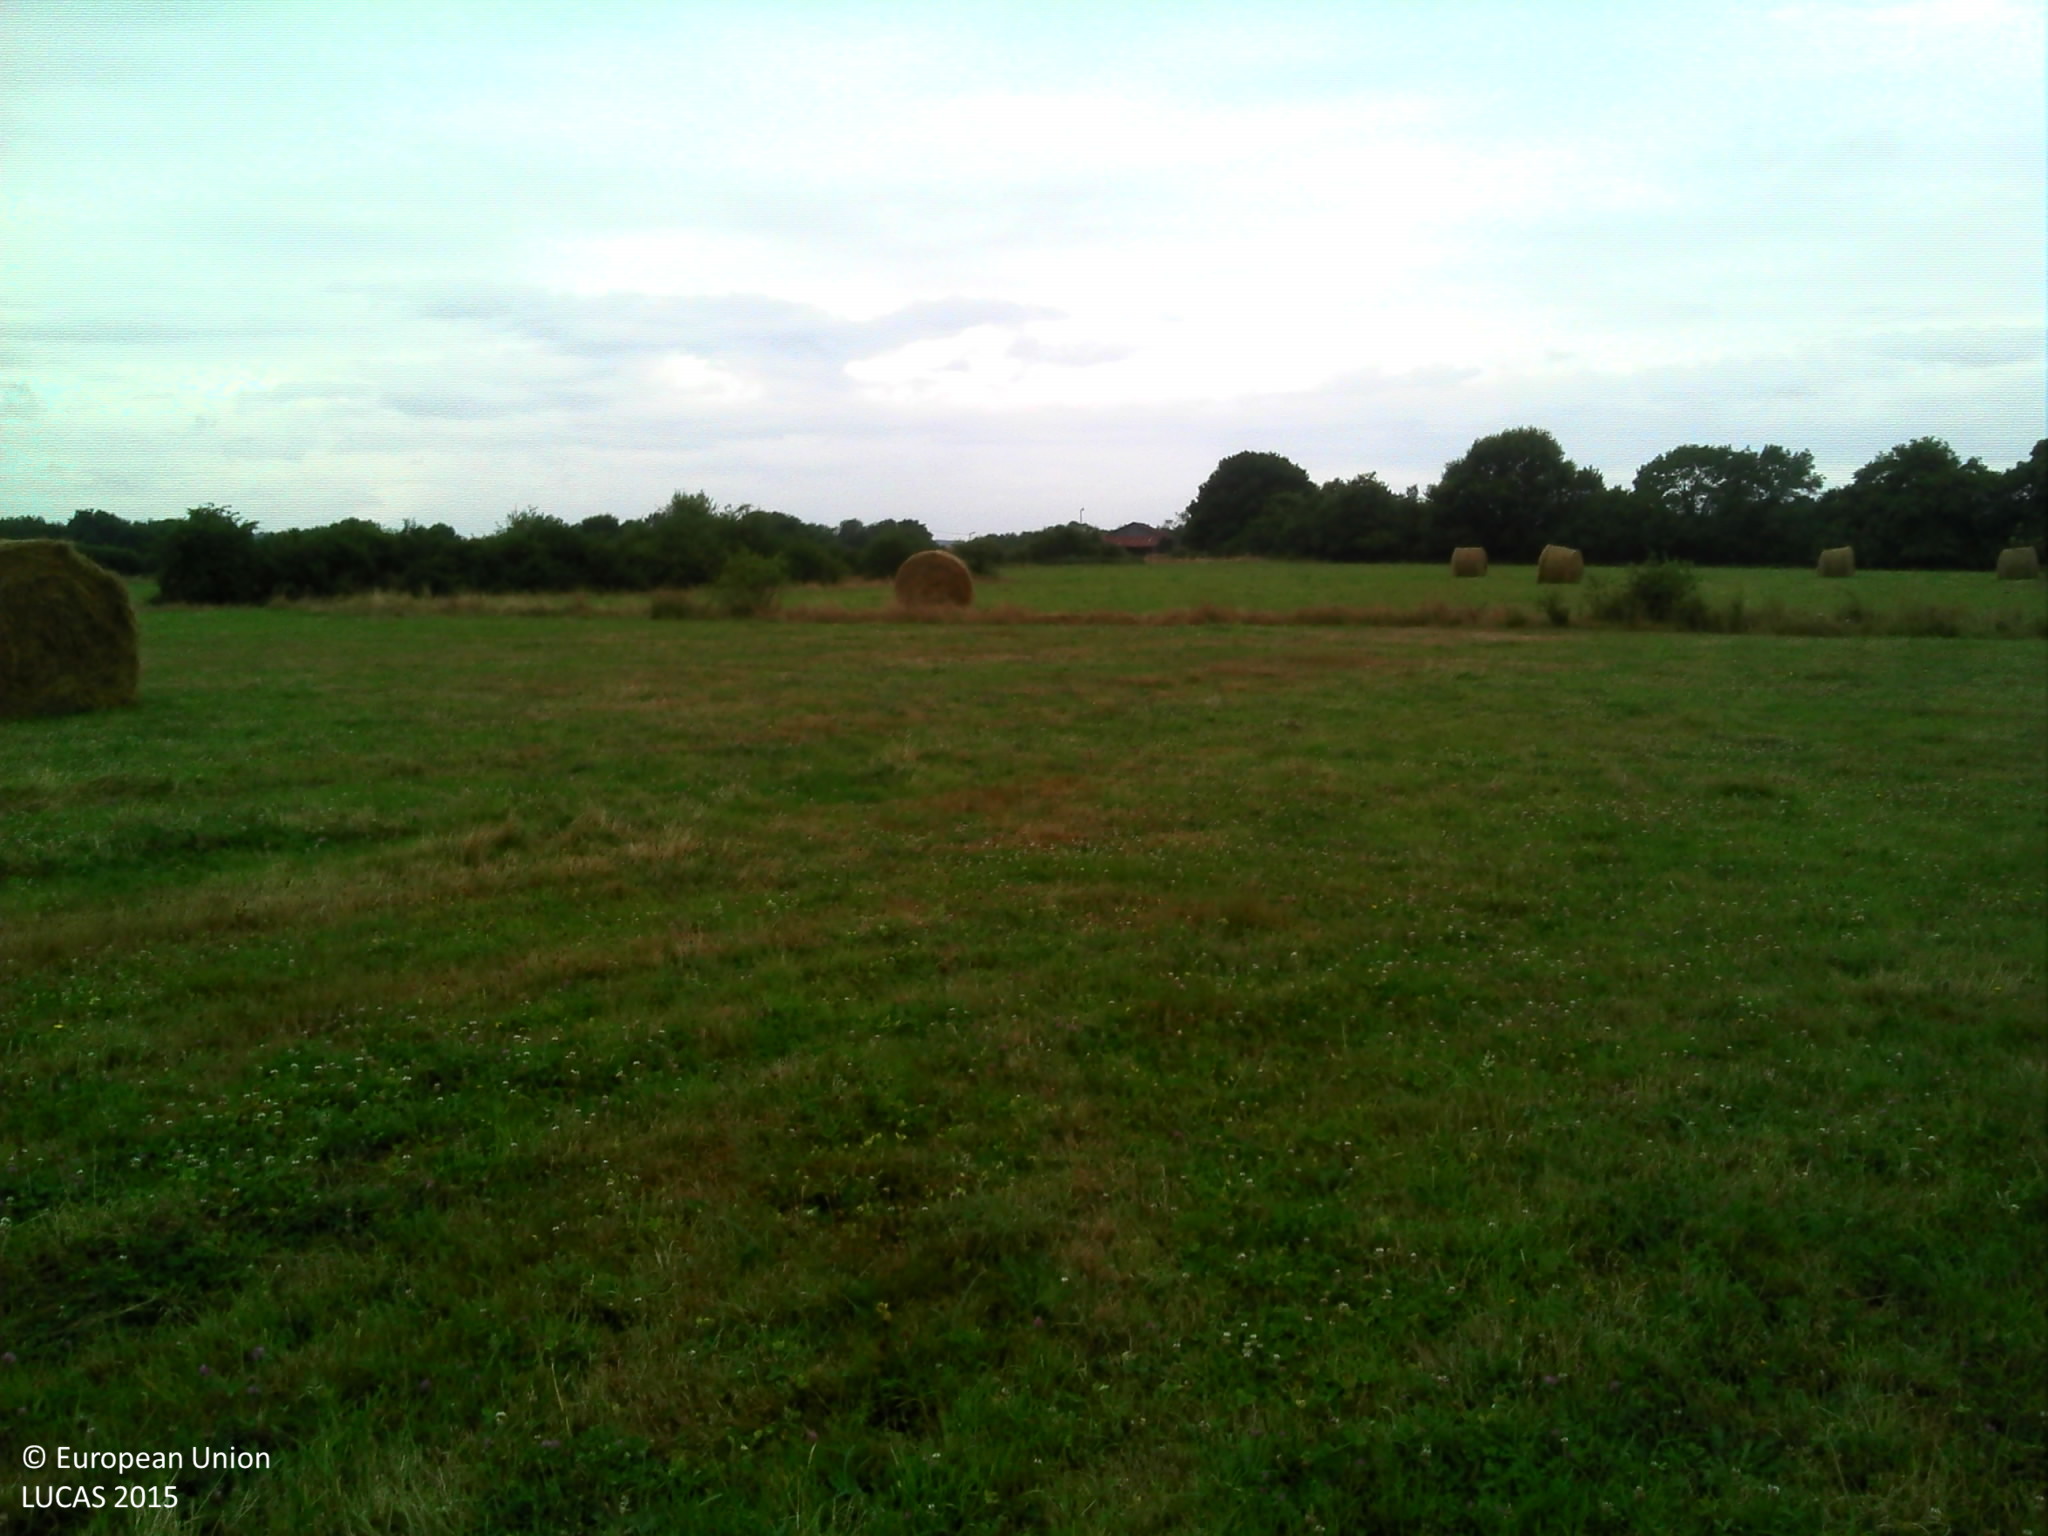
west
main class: Grassland
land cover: Grassland without tree/shrub cover
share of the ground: > 75 %
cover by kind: herbaceous plants 100 %
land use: Agriculture (excluding fallow land and kitchen gardens)
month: July
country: FR
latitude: 47.1839
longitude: -1.8300
